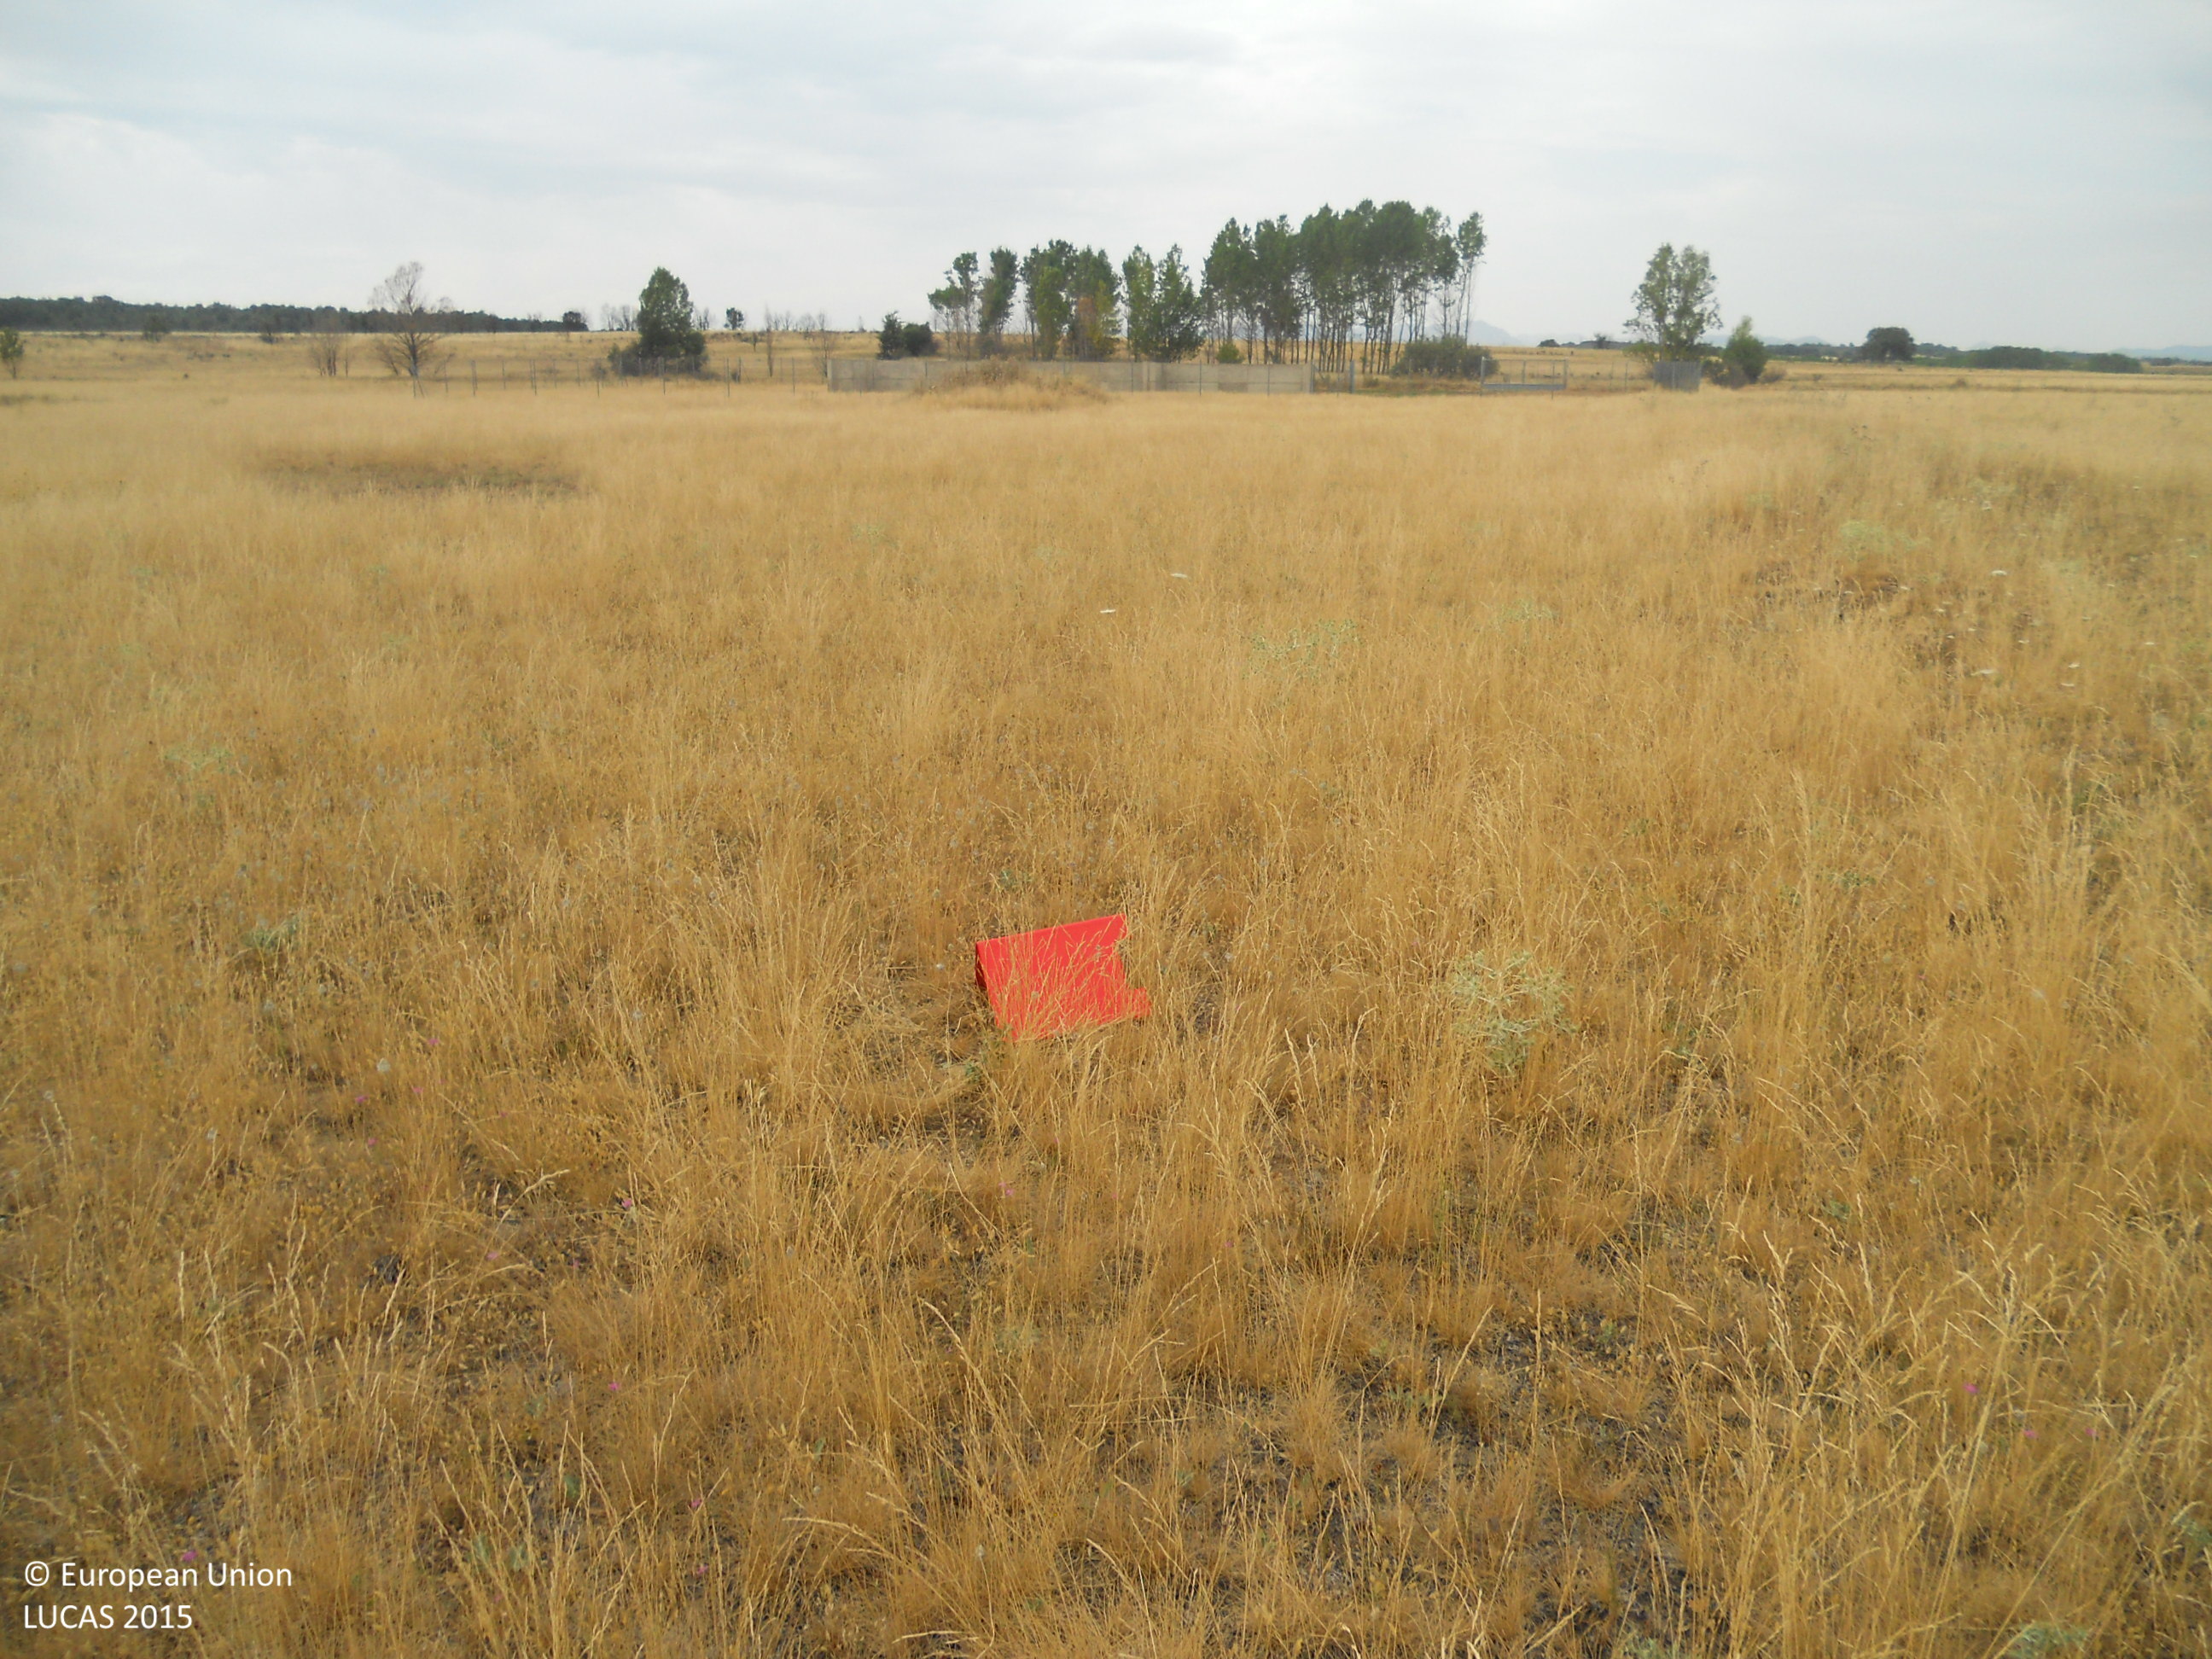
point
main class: Grassland
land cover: Spontaneously vegetated surfaces
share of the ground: > 75 %
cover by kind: herbaceous plants 100 %
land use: Fallow land
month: July
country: ES
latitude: 42.6211
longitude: -5.4197
